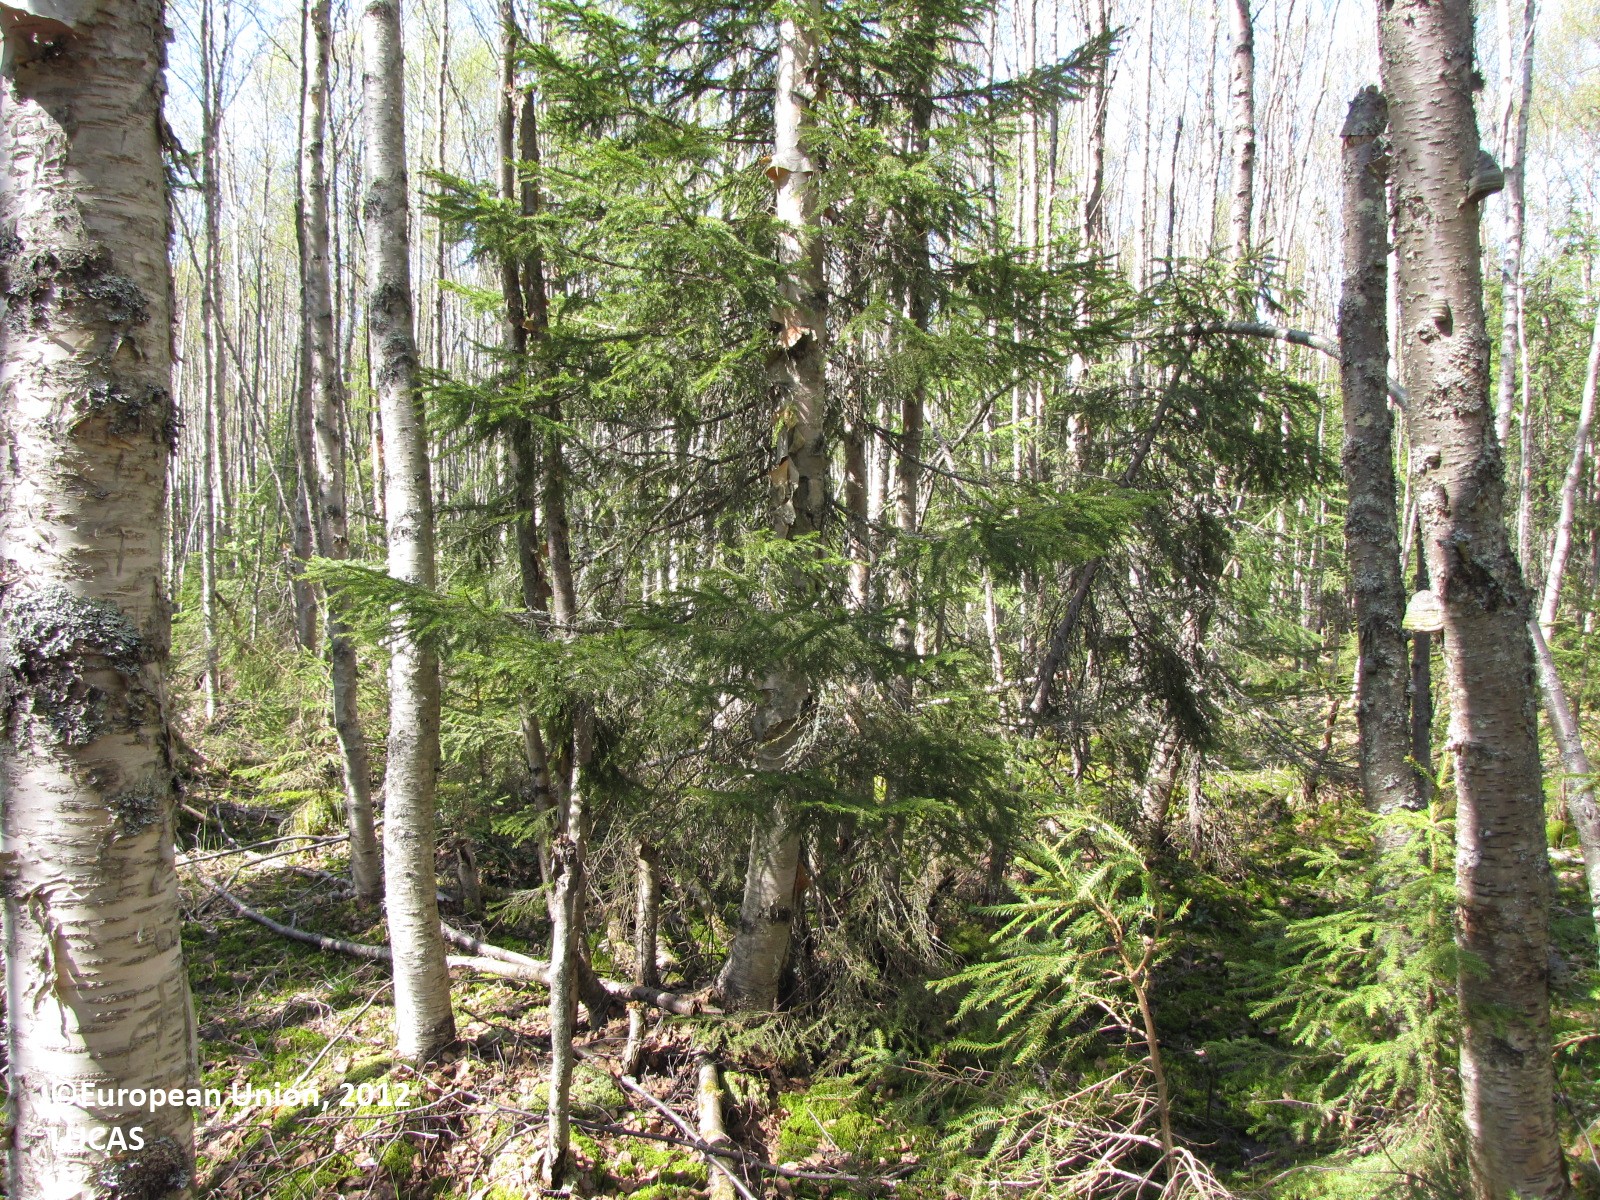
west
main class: Woodland
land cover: Spruce dominated mixed woodland
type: boreal forest
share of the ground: > 75 %
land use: Forestry
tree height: > 5 m
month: May
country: FI
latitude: 65.7431
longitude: 24.6508
